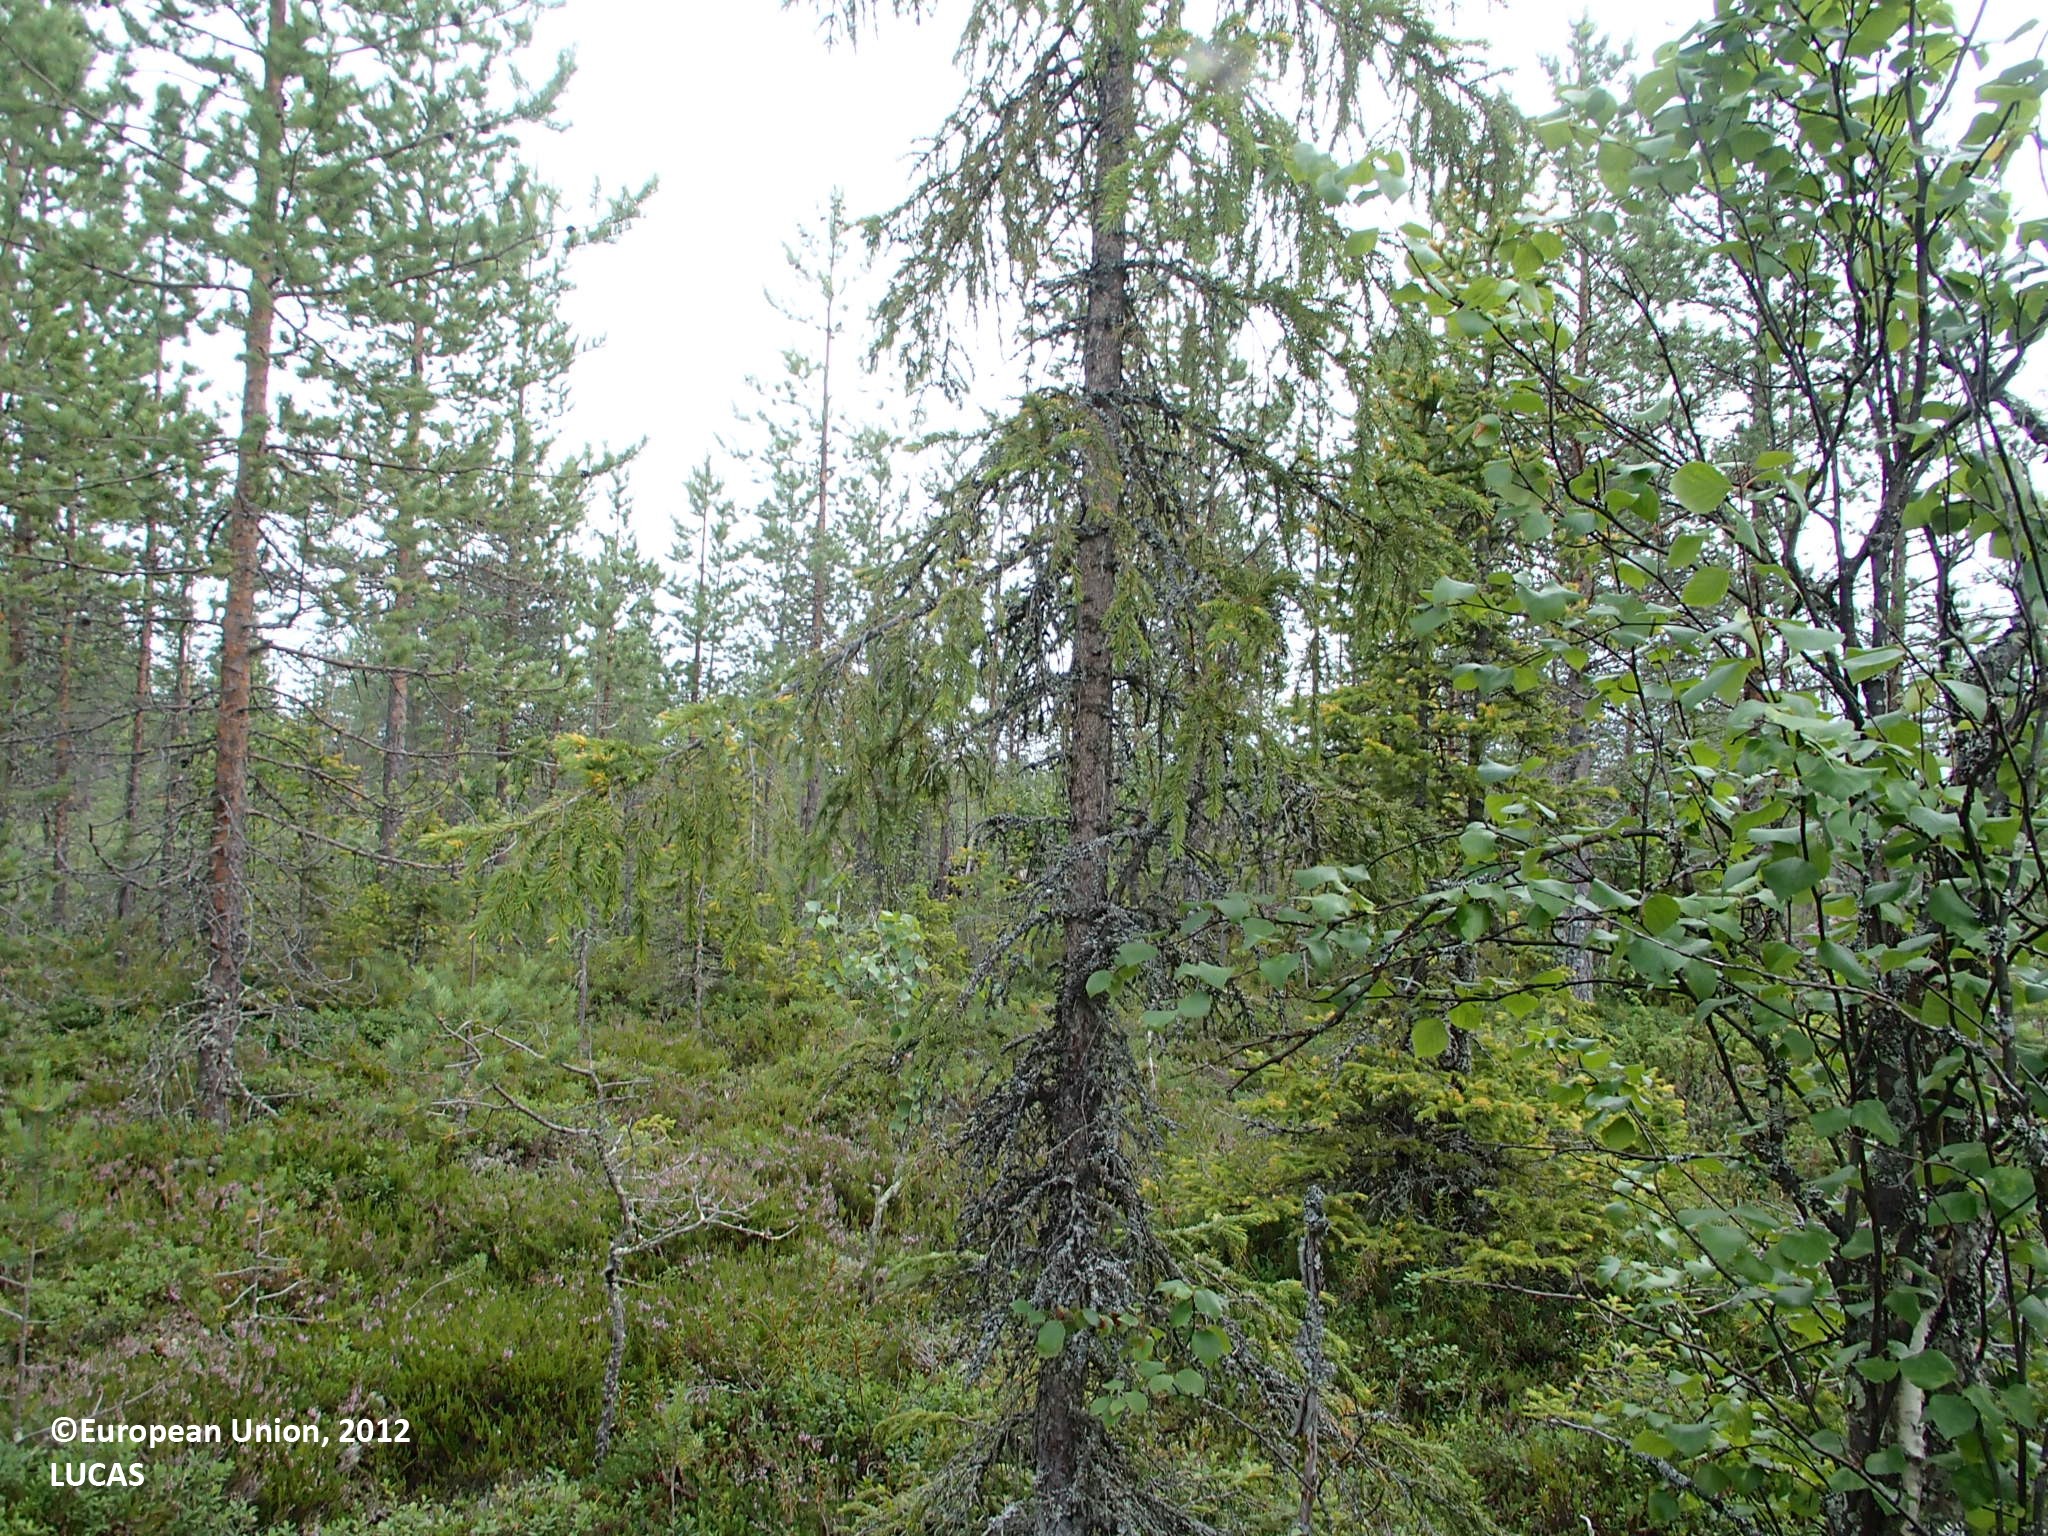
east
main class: Woodland
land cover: Other coniferous woodland
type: boreal forest
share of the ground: 50 - 75 %
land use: Forestry
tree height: > 5 m
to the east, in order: Other coniferous woodland; Ditches and canals; Pine dominated coniferous woodland
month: July
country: FI
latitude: 66.1614
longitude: 25.3428
